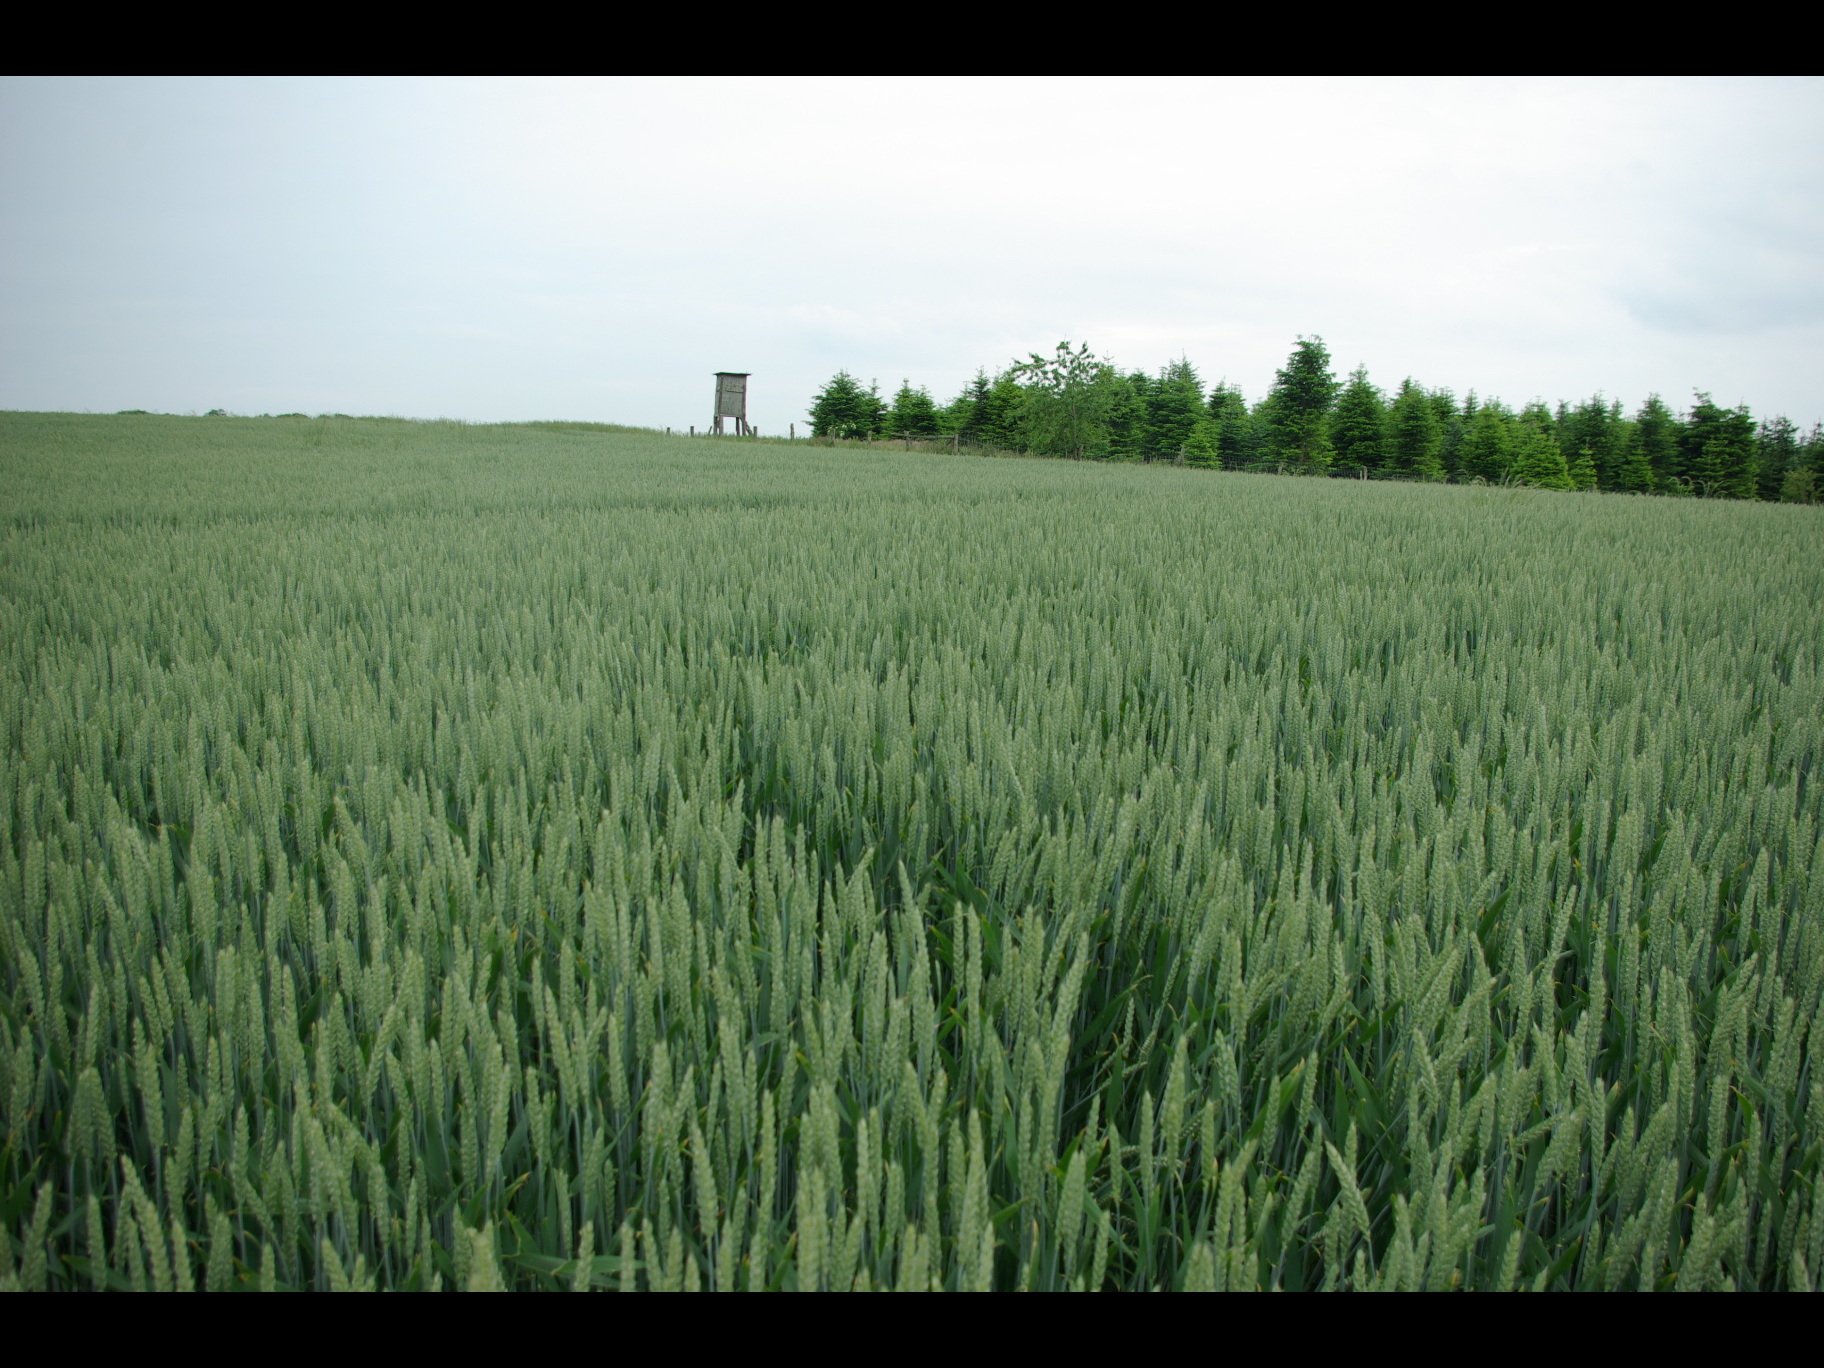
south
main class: Cropland
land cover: Common wheat
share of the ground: > 75 %
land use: Agriculture (excluding fallow land and kitchen gardens)
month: June
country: DE
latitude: 54.5162
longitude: 9.9228
